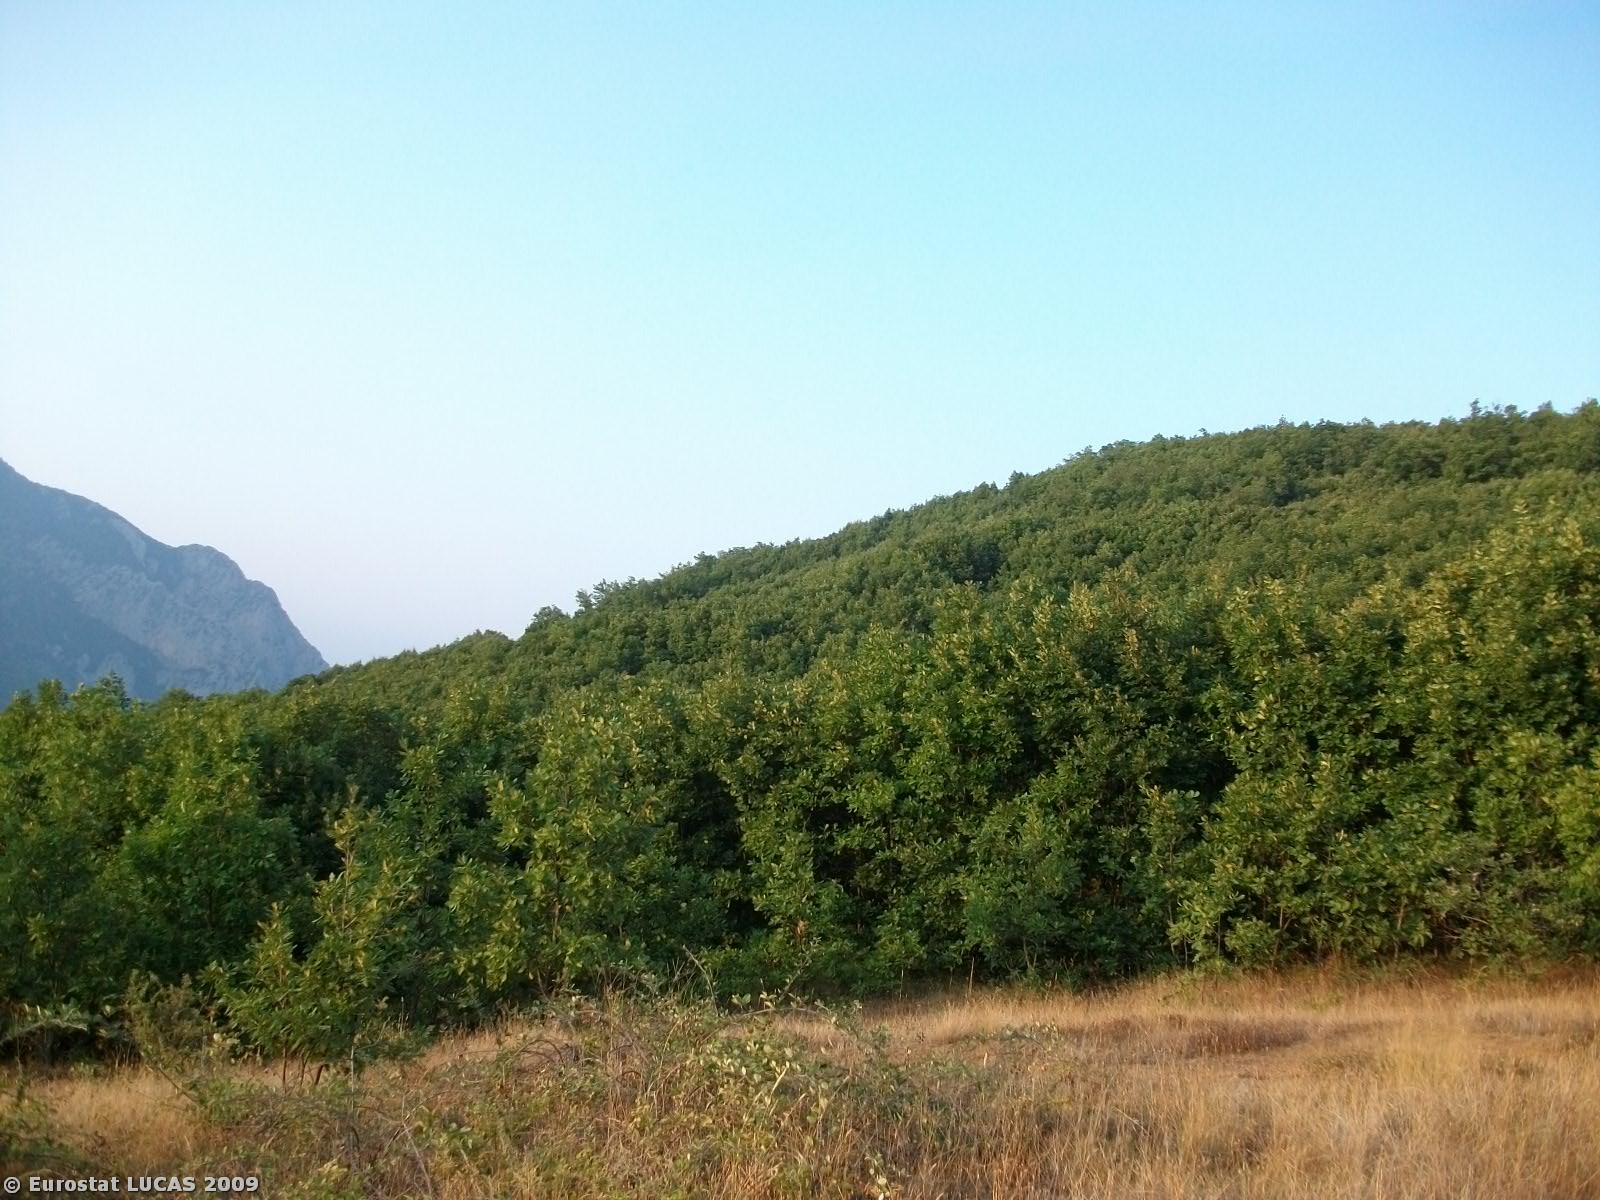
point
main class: Woodland
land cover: Broadleaved woodland
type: thermophilous deciduous forest
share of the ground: > 75 %
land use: Forestry
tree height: > 5 m
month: August
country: GR
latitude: 39.4323
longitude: 21.5866
